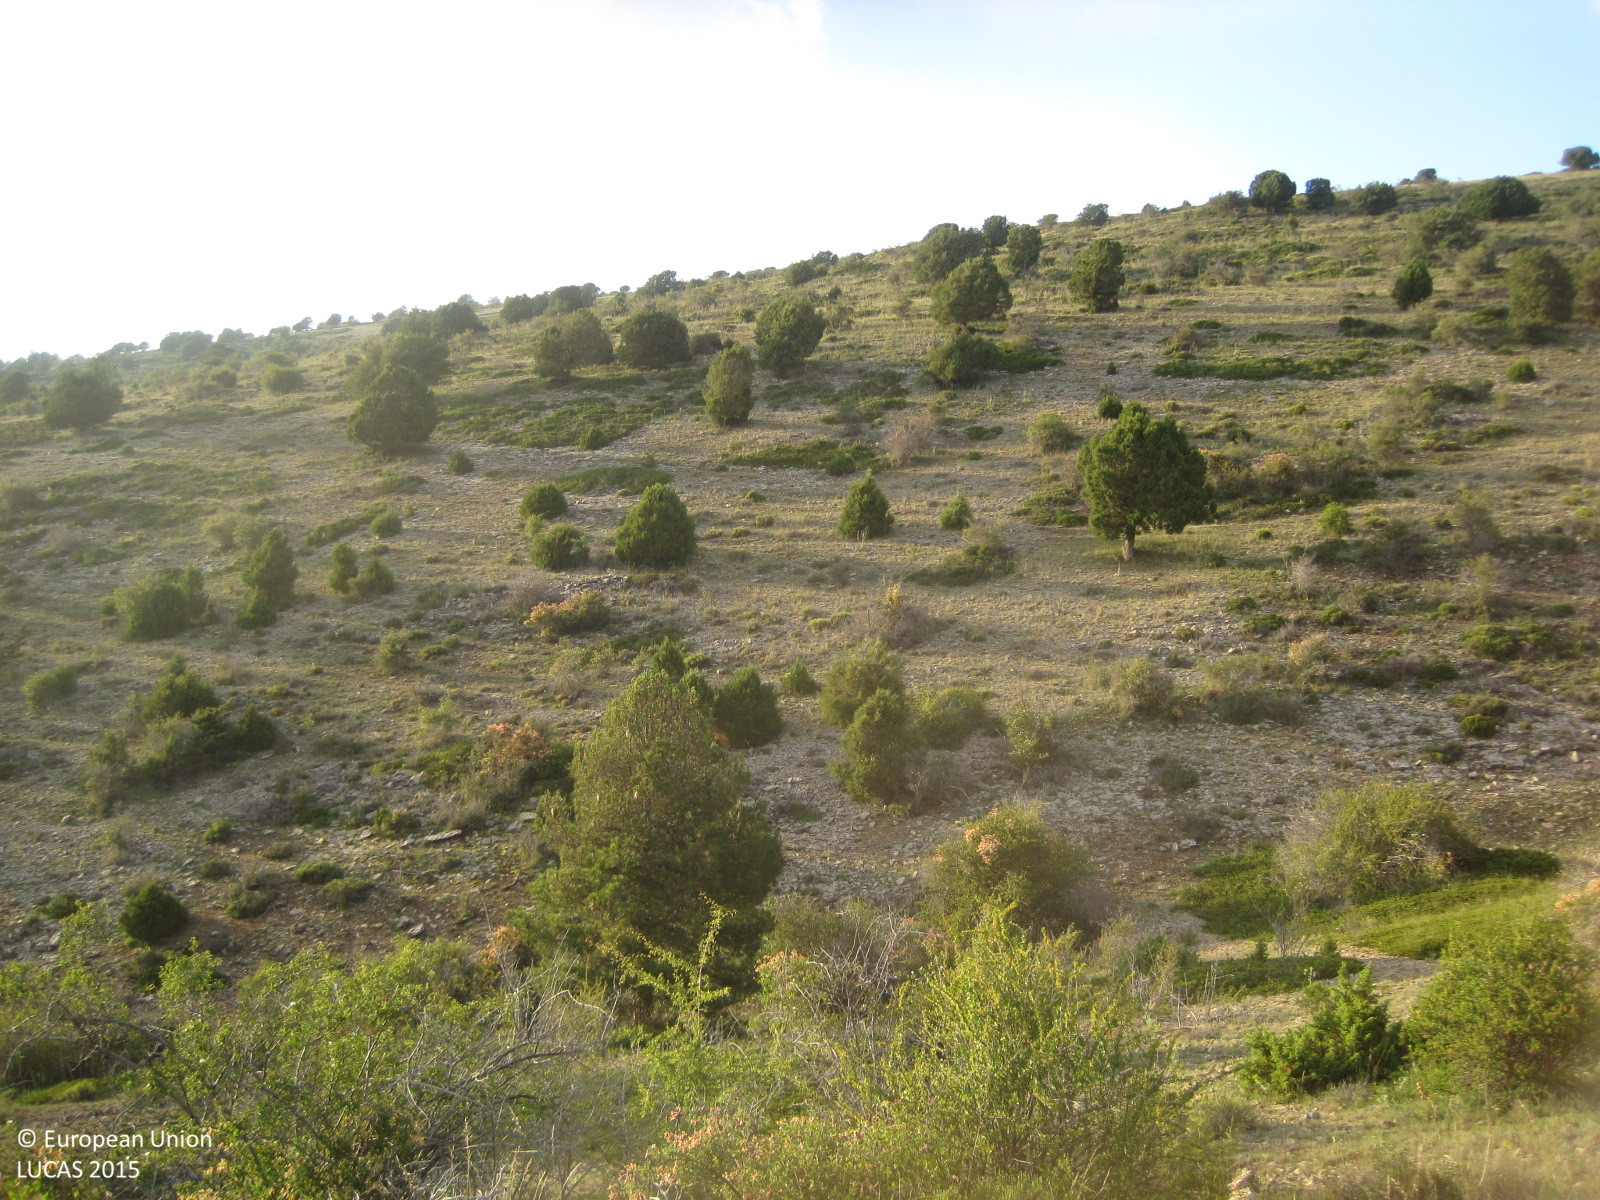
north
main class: Shrubland
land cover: Shrubland with sparse tree cover
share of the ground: 10 - 25 %
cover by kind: herbaceous plants 50 %, consolidated bare surface 25 %, shrubs 20 %, coniferous forest trees 5 %
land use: Semi-natural and natural areas not in use
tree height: < 5 m
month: June
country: ES
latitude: 39.9830
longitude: -0.9314
